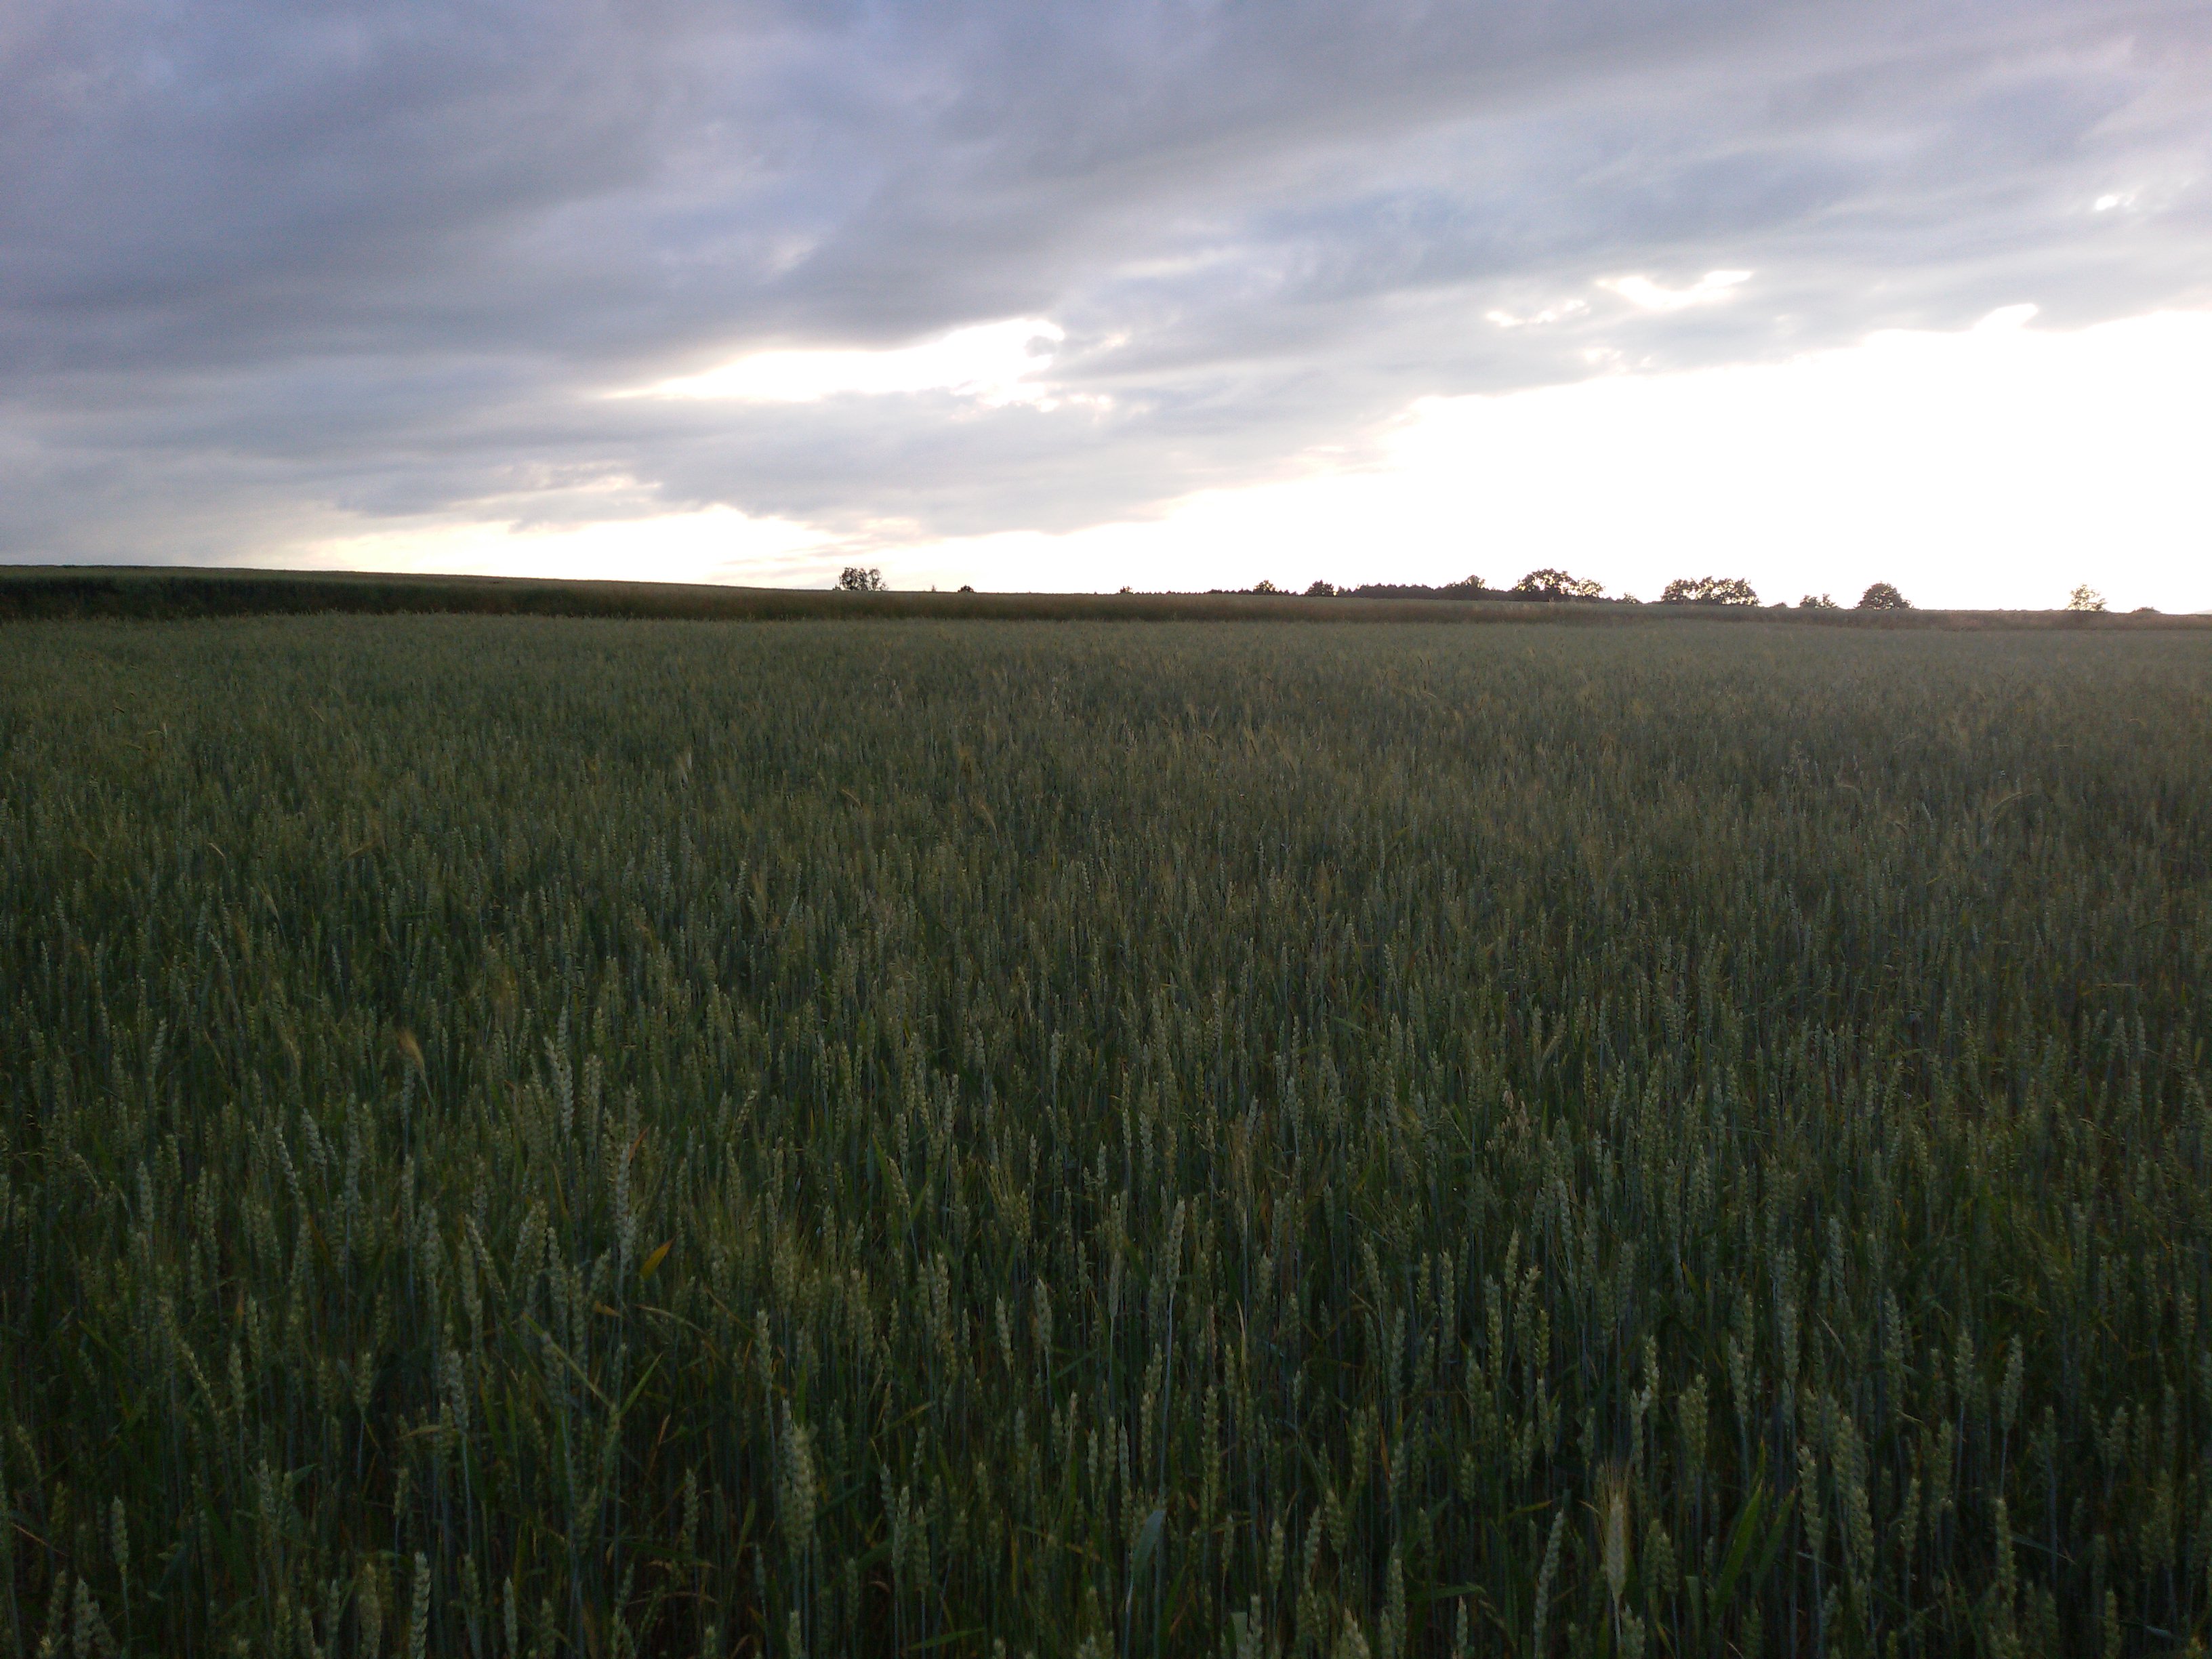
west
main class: Cropland
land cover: Common wheat
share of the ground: > 75 %
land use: Agriculture (excluding fallow land and kitchen gardens)
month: June
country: PL
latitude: 50.6599
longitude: 17.2116
